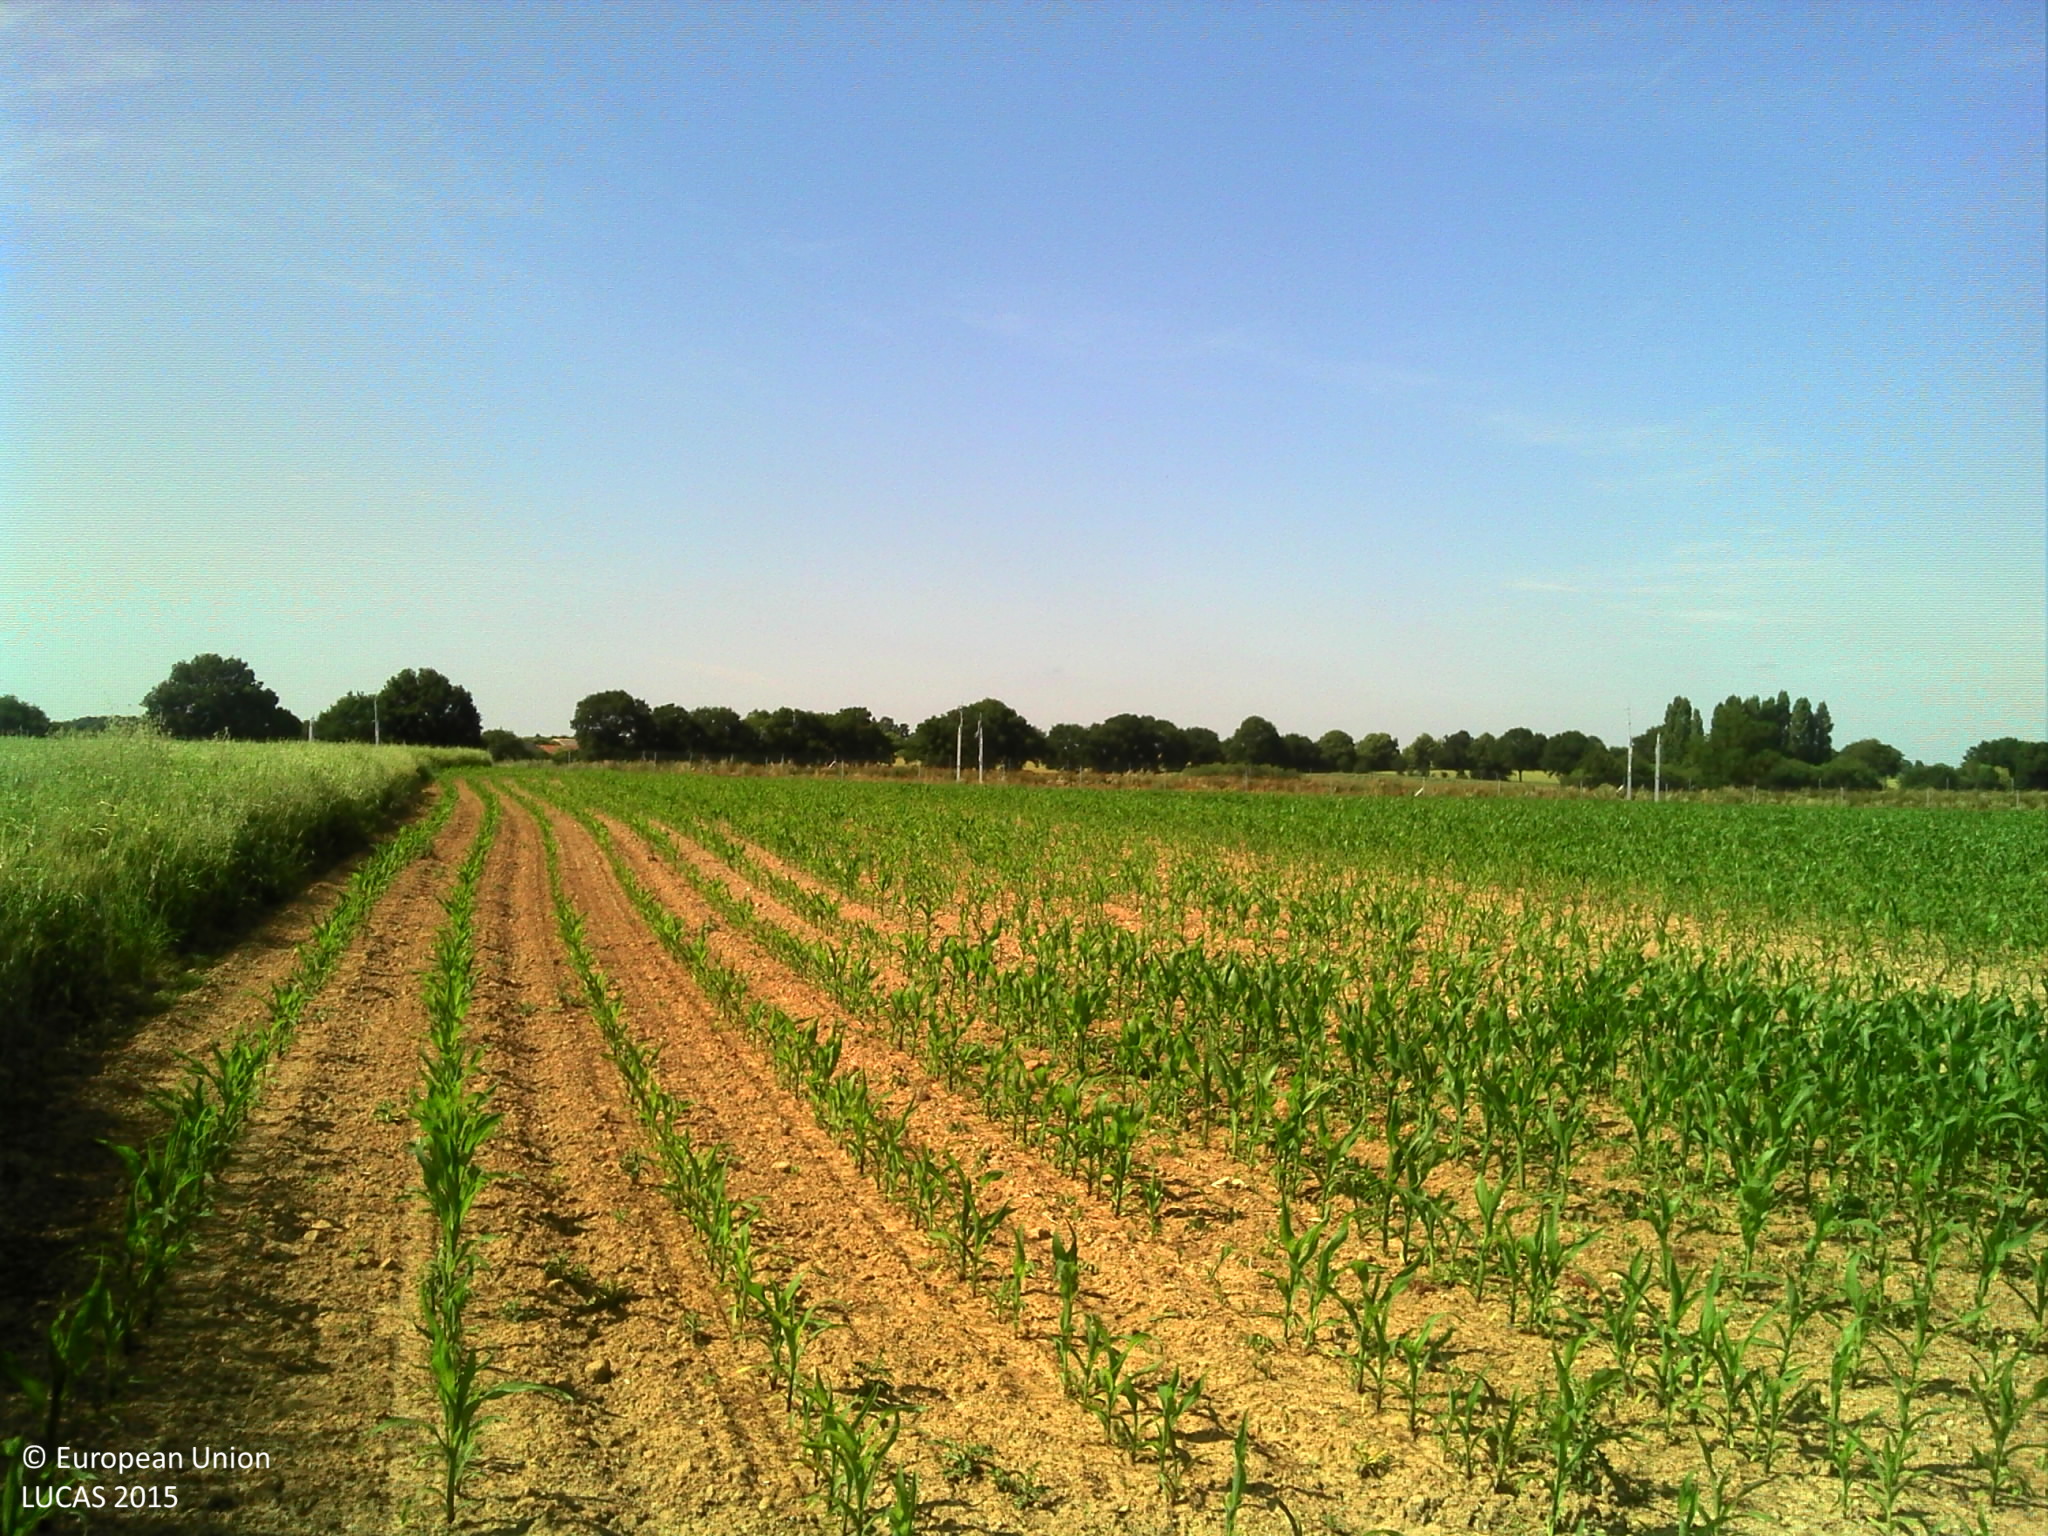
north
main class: Cropland
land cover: Maize
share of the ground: 10 - 25 %
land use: Agriculture (excluding fallow land and kitchen gardens)
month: June
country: FR
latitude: 48.0623
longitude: -1.4370
